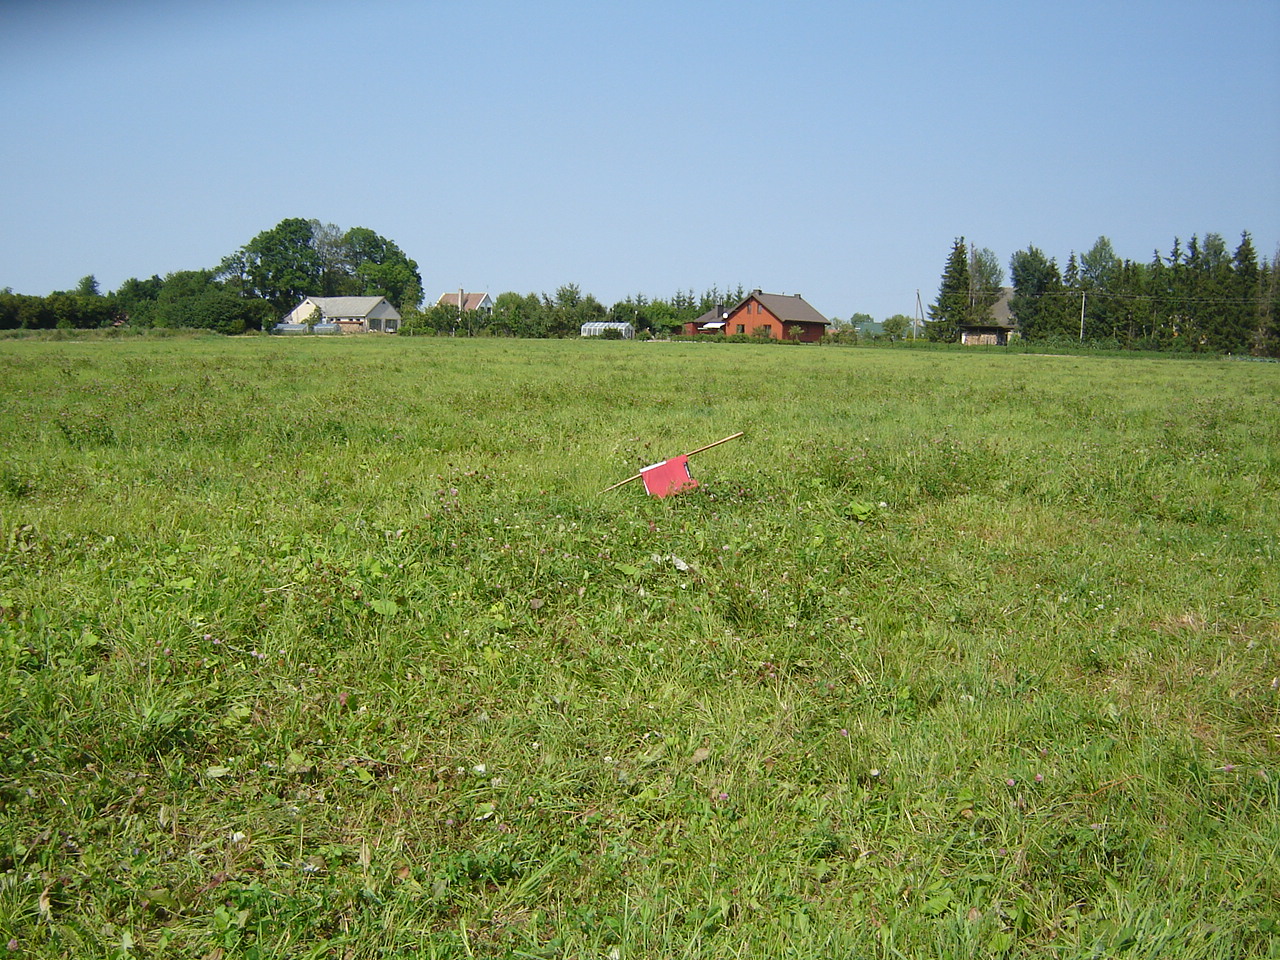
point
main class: Grassland
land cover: Grassland without tree/shrub cover
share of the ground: > 75 %
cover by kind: herbaceous plants 100 %
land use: Agriculture (excluding fallow land and kitchen gardens)
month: August
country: LT
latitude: 55.0289
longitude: 24.9588
